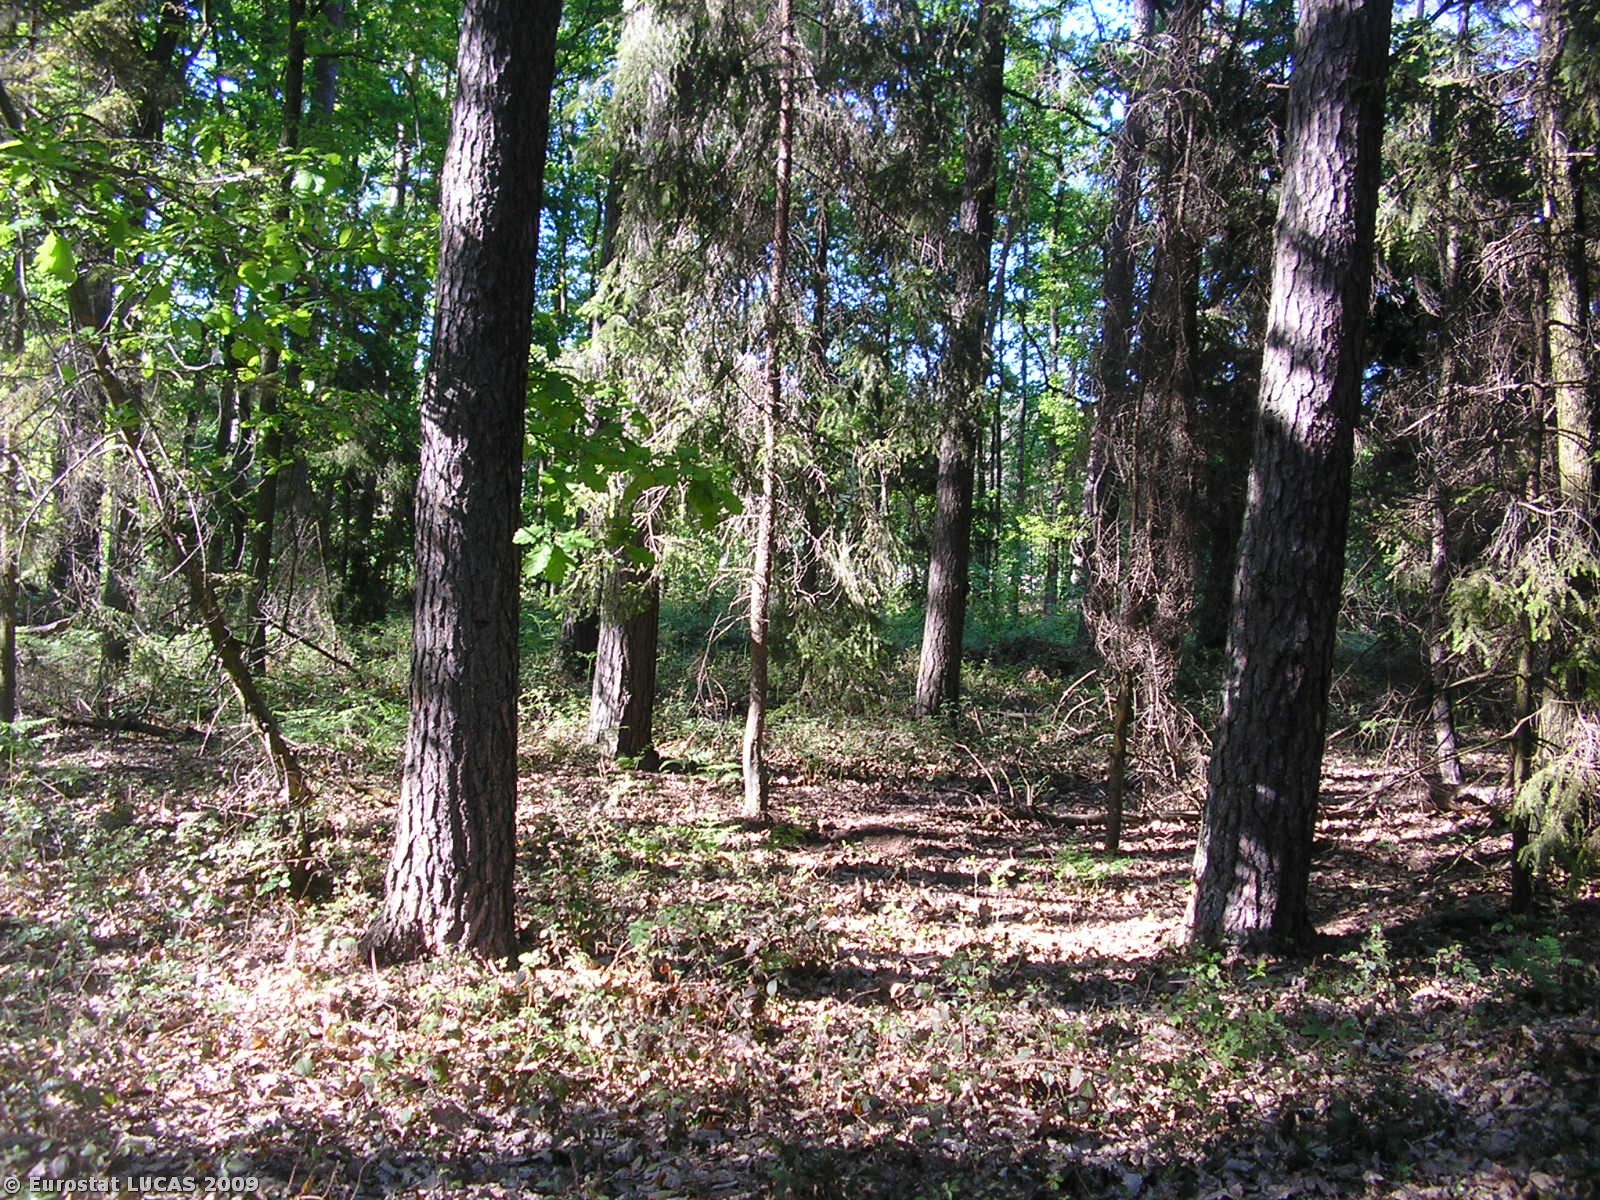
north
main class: Woodland
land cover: Mixed woodland
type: hemiboreal forest and nemoral coniferous forest and mixed broadleaved-coniferous forest
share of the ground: > 75 %
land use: Forestry
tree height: > 5 m
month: May
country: PL
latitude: 51.6292
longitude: 19.9863
